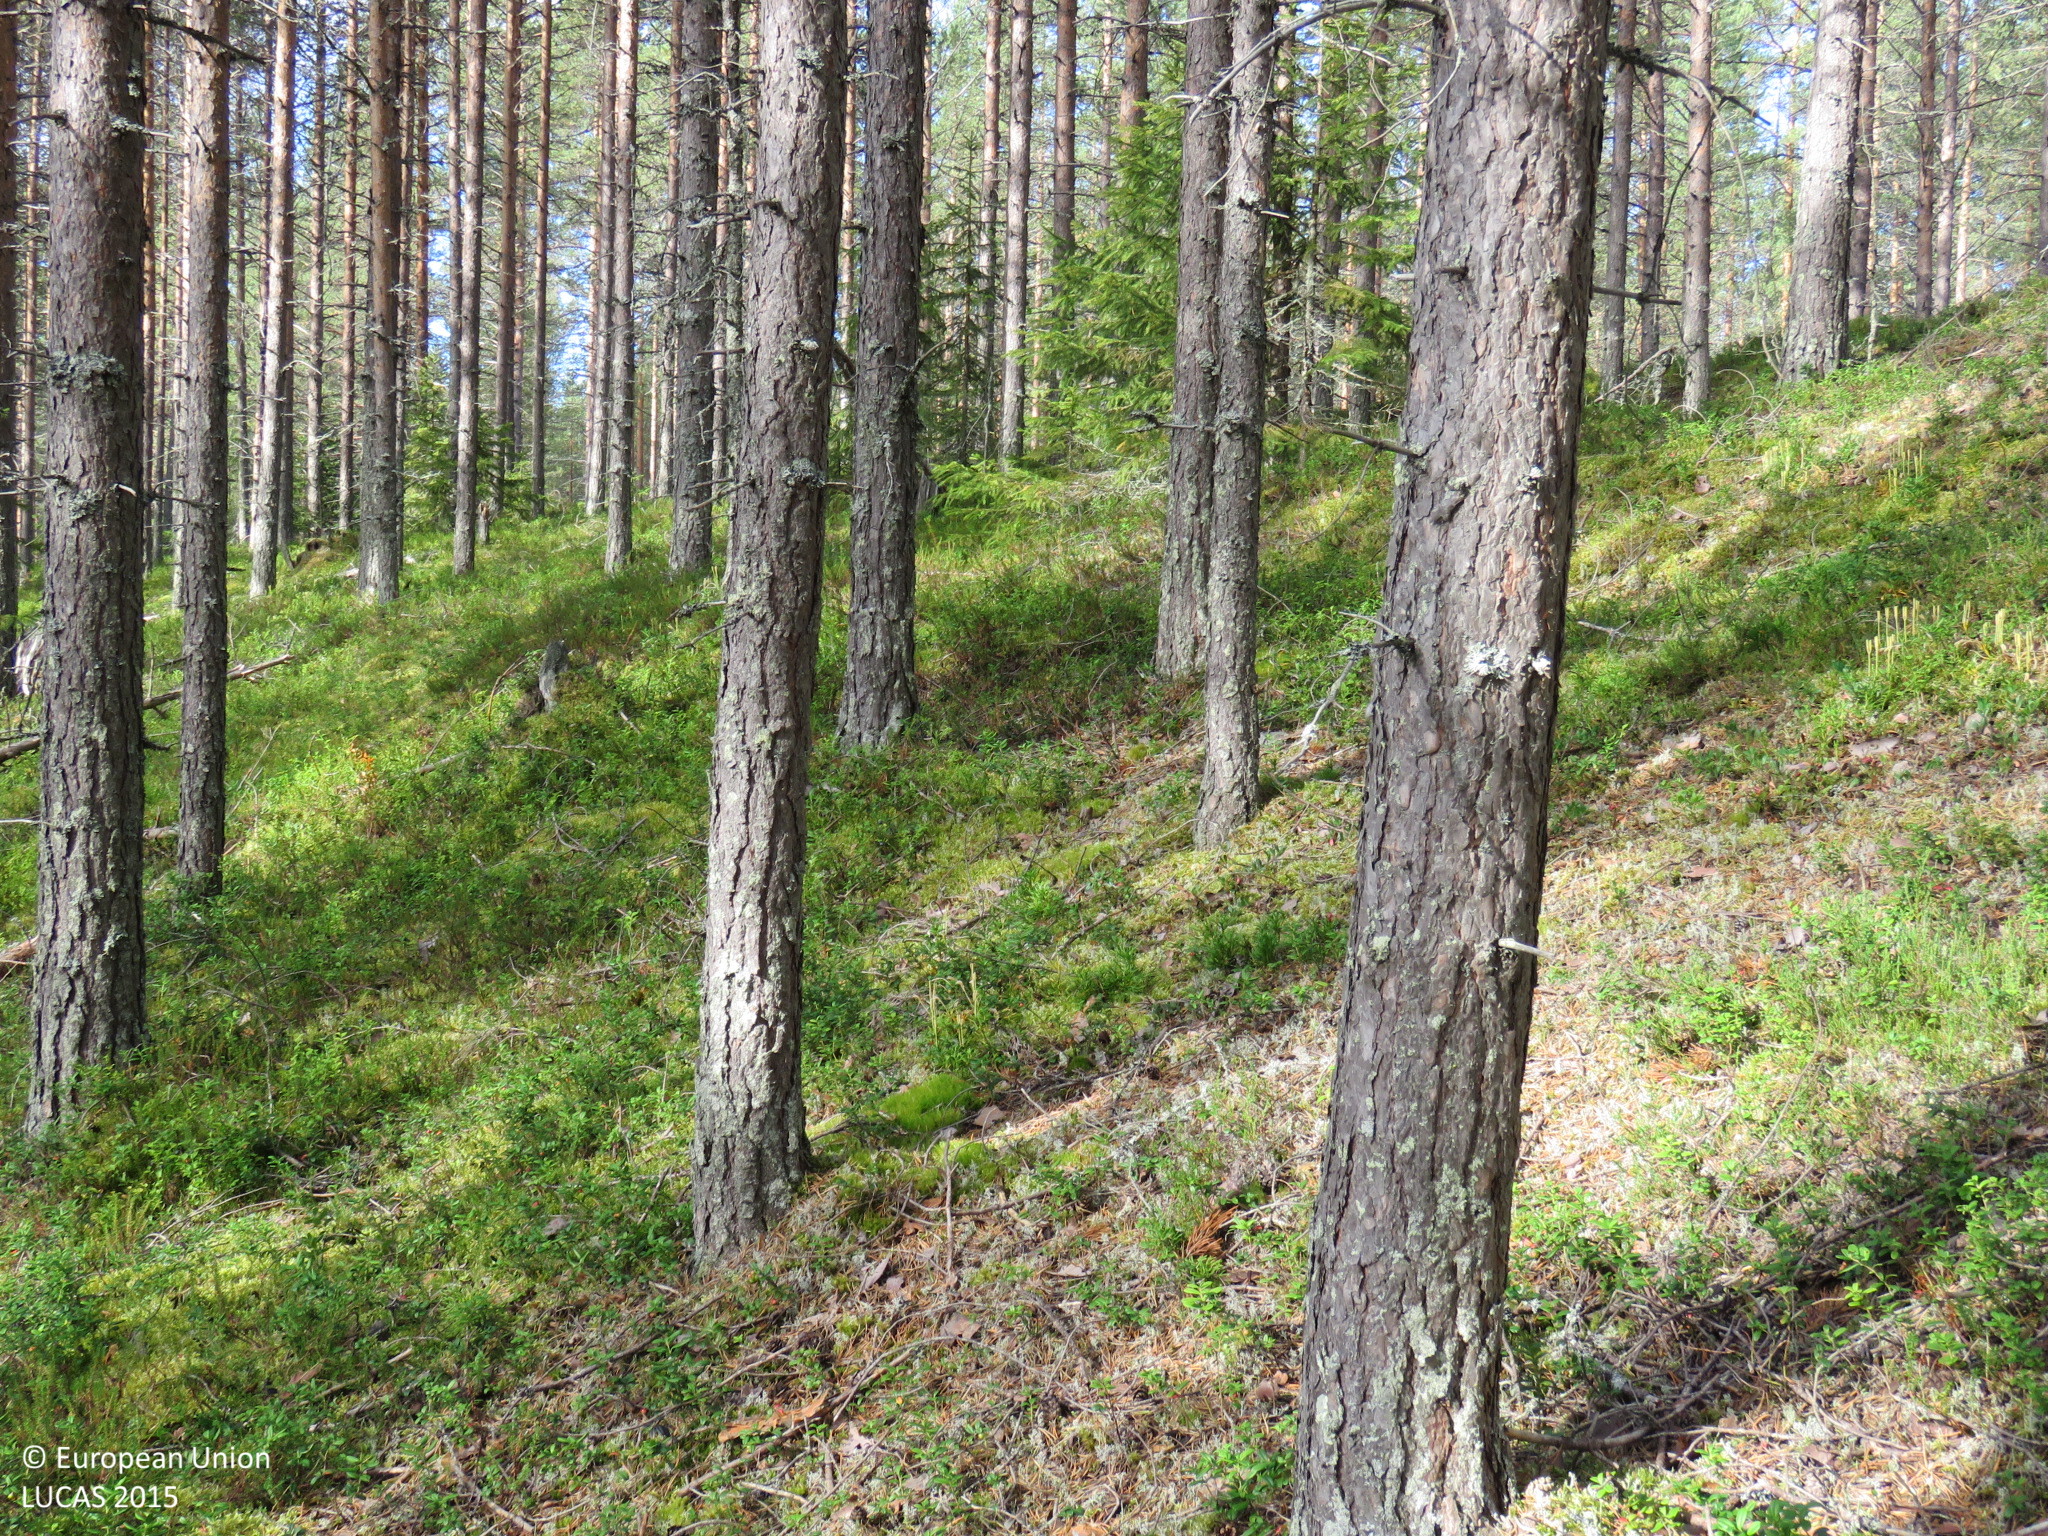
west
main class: Woodland
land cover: Pine dominated coniferous woodland
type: boreal forest
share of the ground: > 75 %
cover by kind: coniferous forest trees 80 %, shrubs 15 %, lichens and mosses 5 %
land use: Forestry
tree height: > 5 m
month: September
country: FI
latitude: 65.4352
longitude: 27.5727
